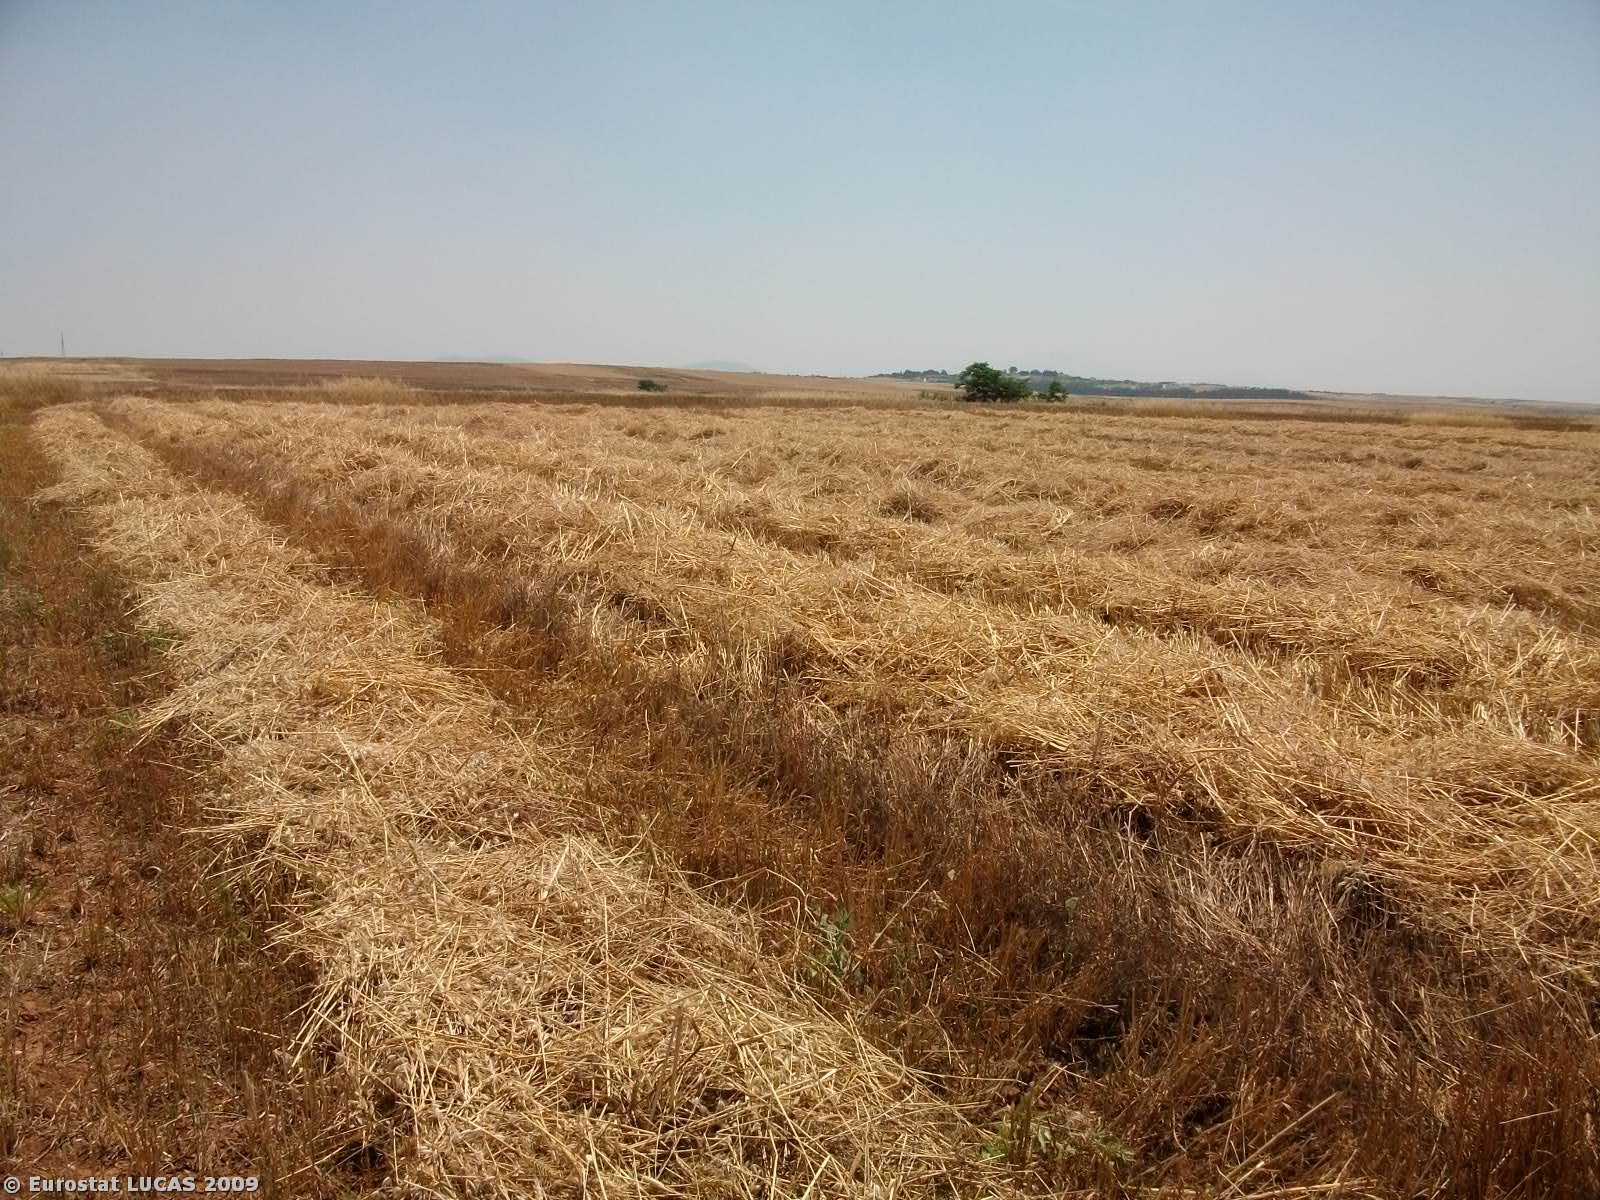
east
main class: Cropland
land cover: Common wheat
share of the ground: > 75 %
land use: Agriculture (excluding fallow land and kitchen gardens)
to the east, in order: Common wheat; Grass margins; Common wheat
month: June
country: GR
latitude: 40.7886
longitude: 22.7222
